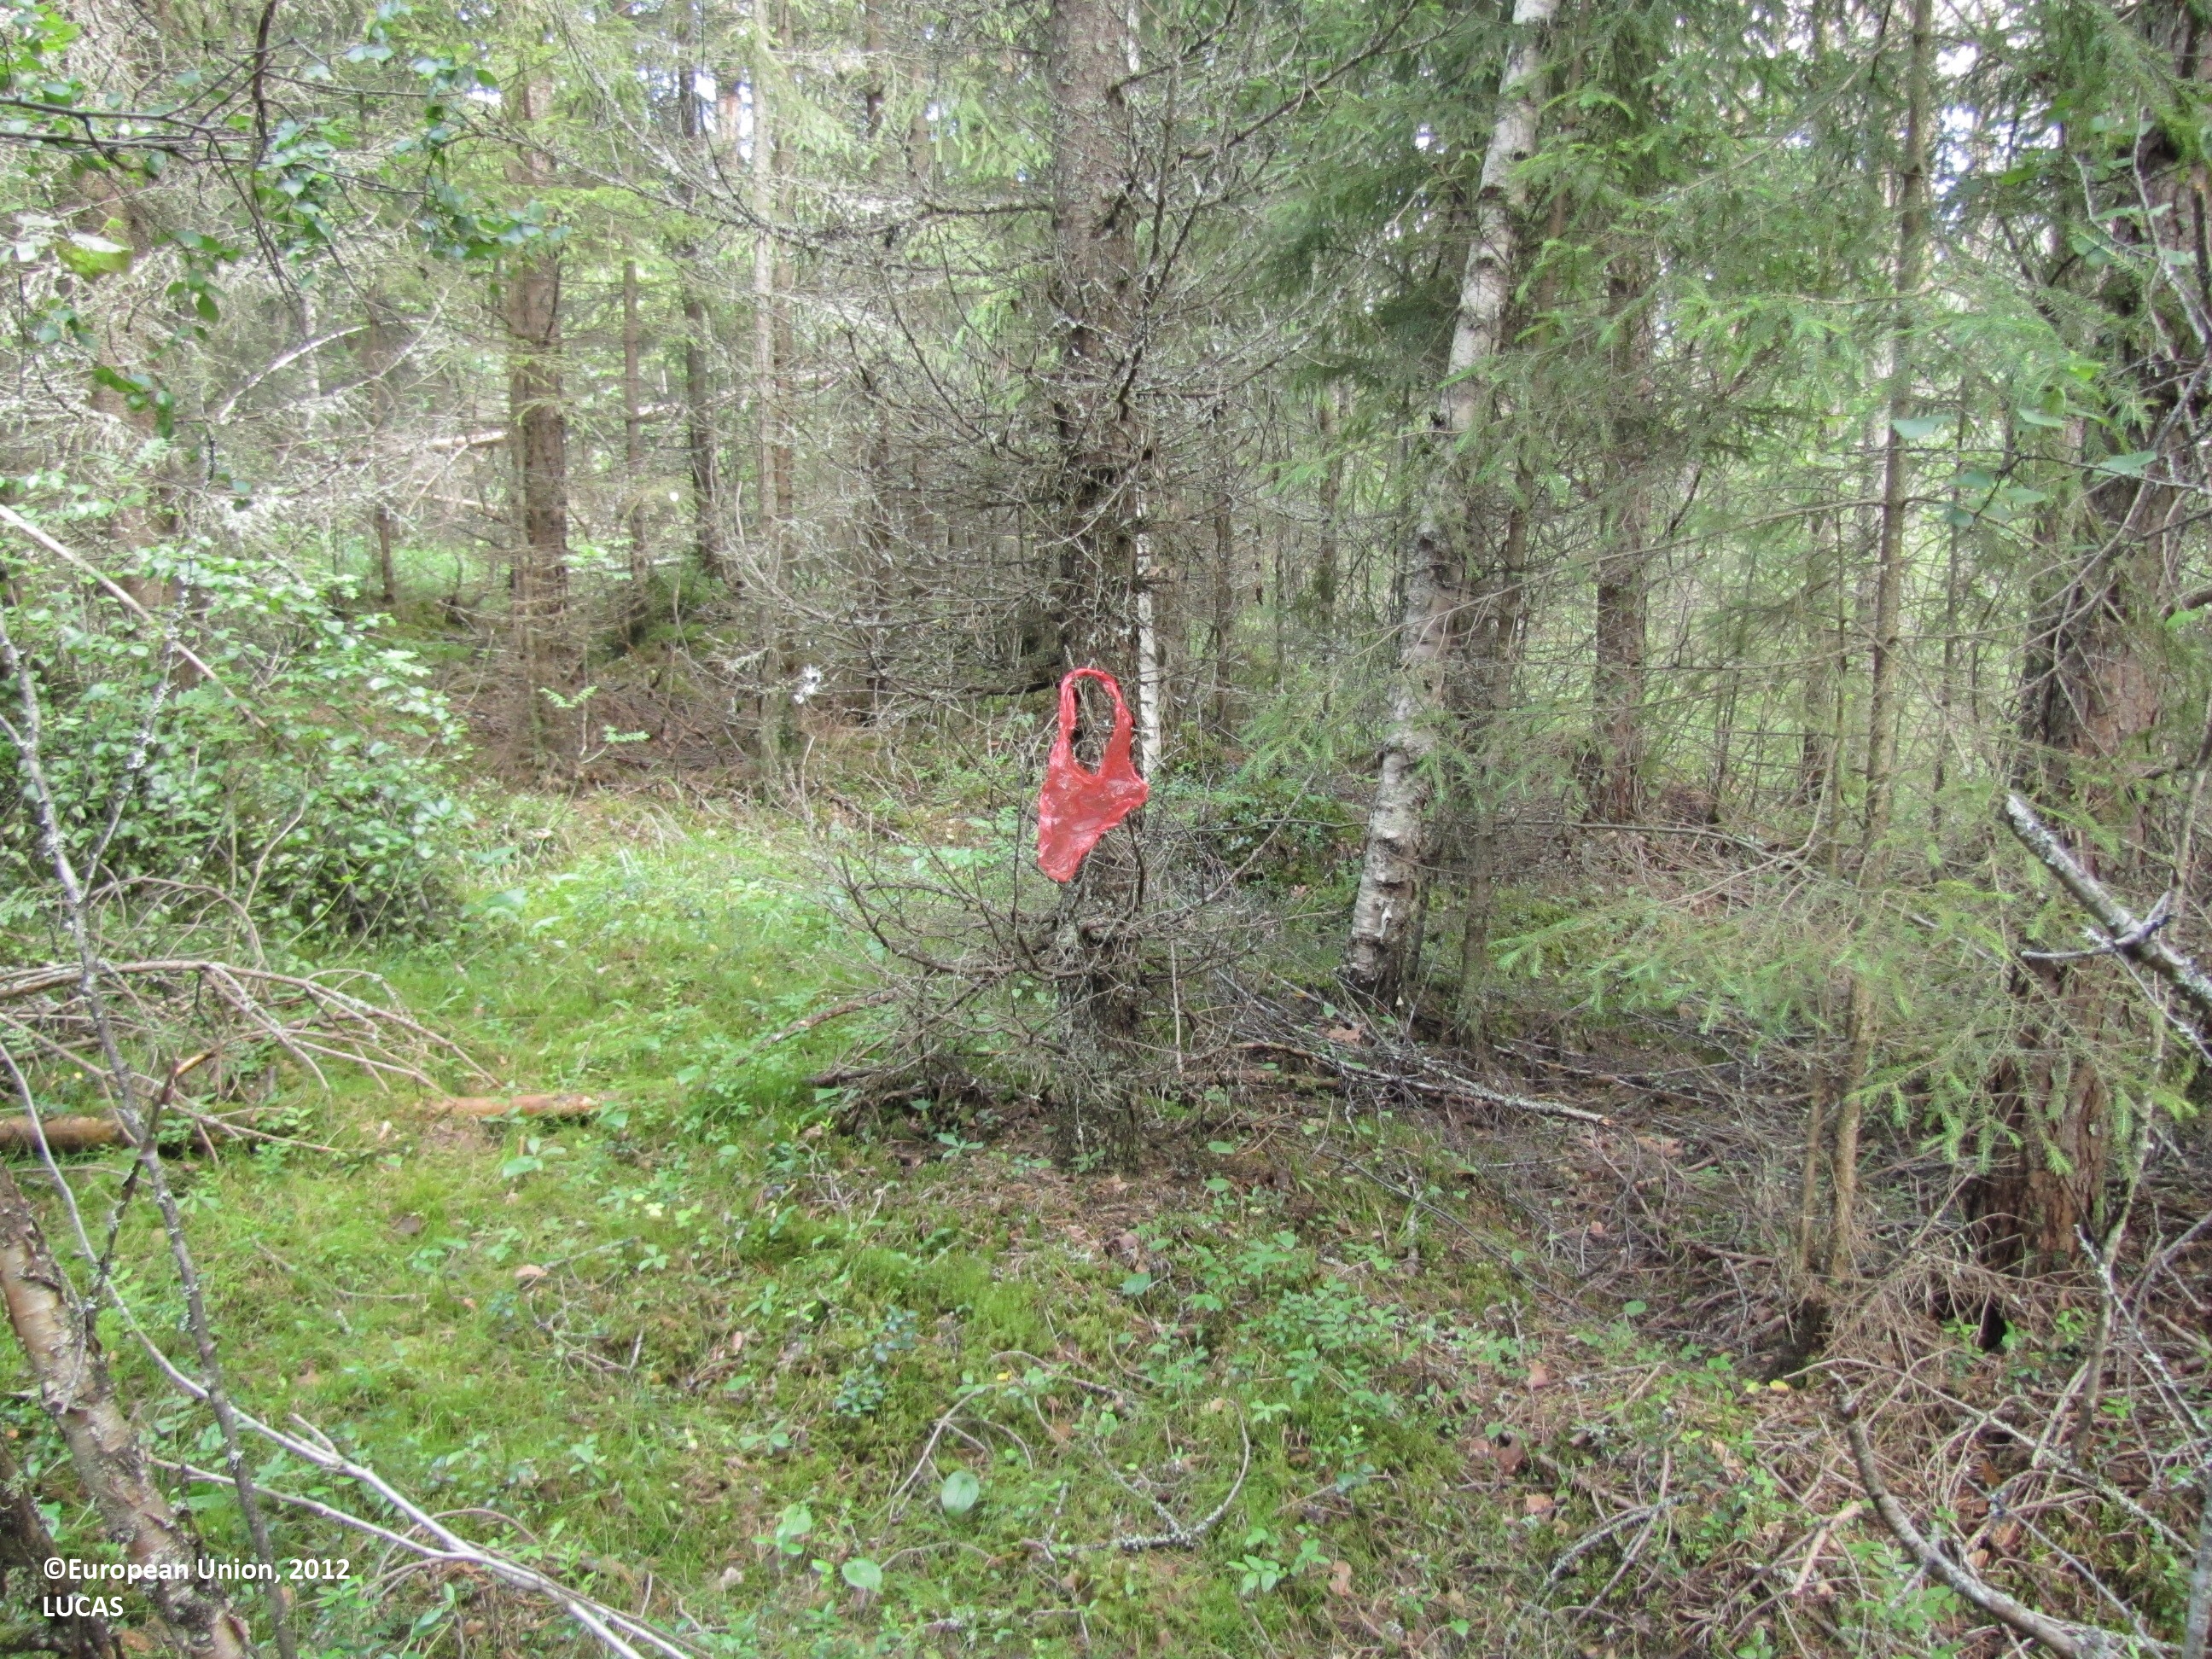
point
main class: Woodland
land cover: Spruce dominated mixed woodland
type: boreal forest
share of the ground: > 75 %
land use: Forestry
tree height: > 5 m
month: July
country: FI
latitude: 62.0919
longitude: 23.3049
